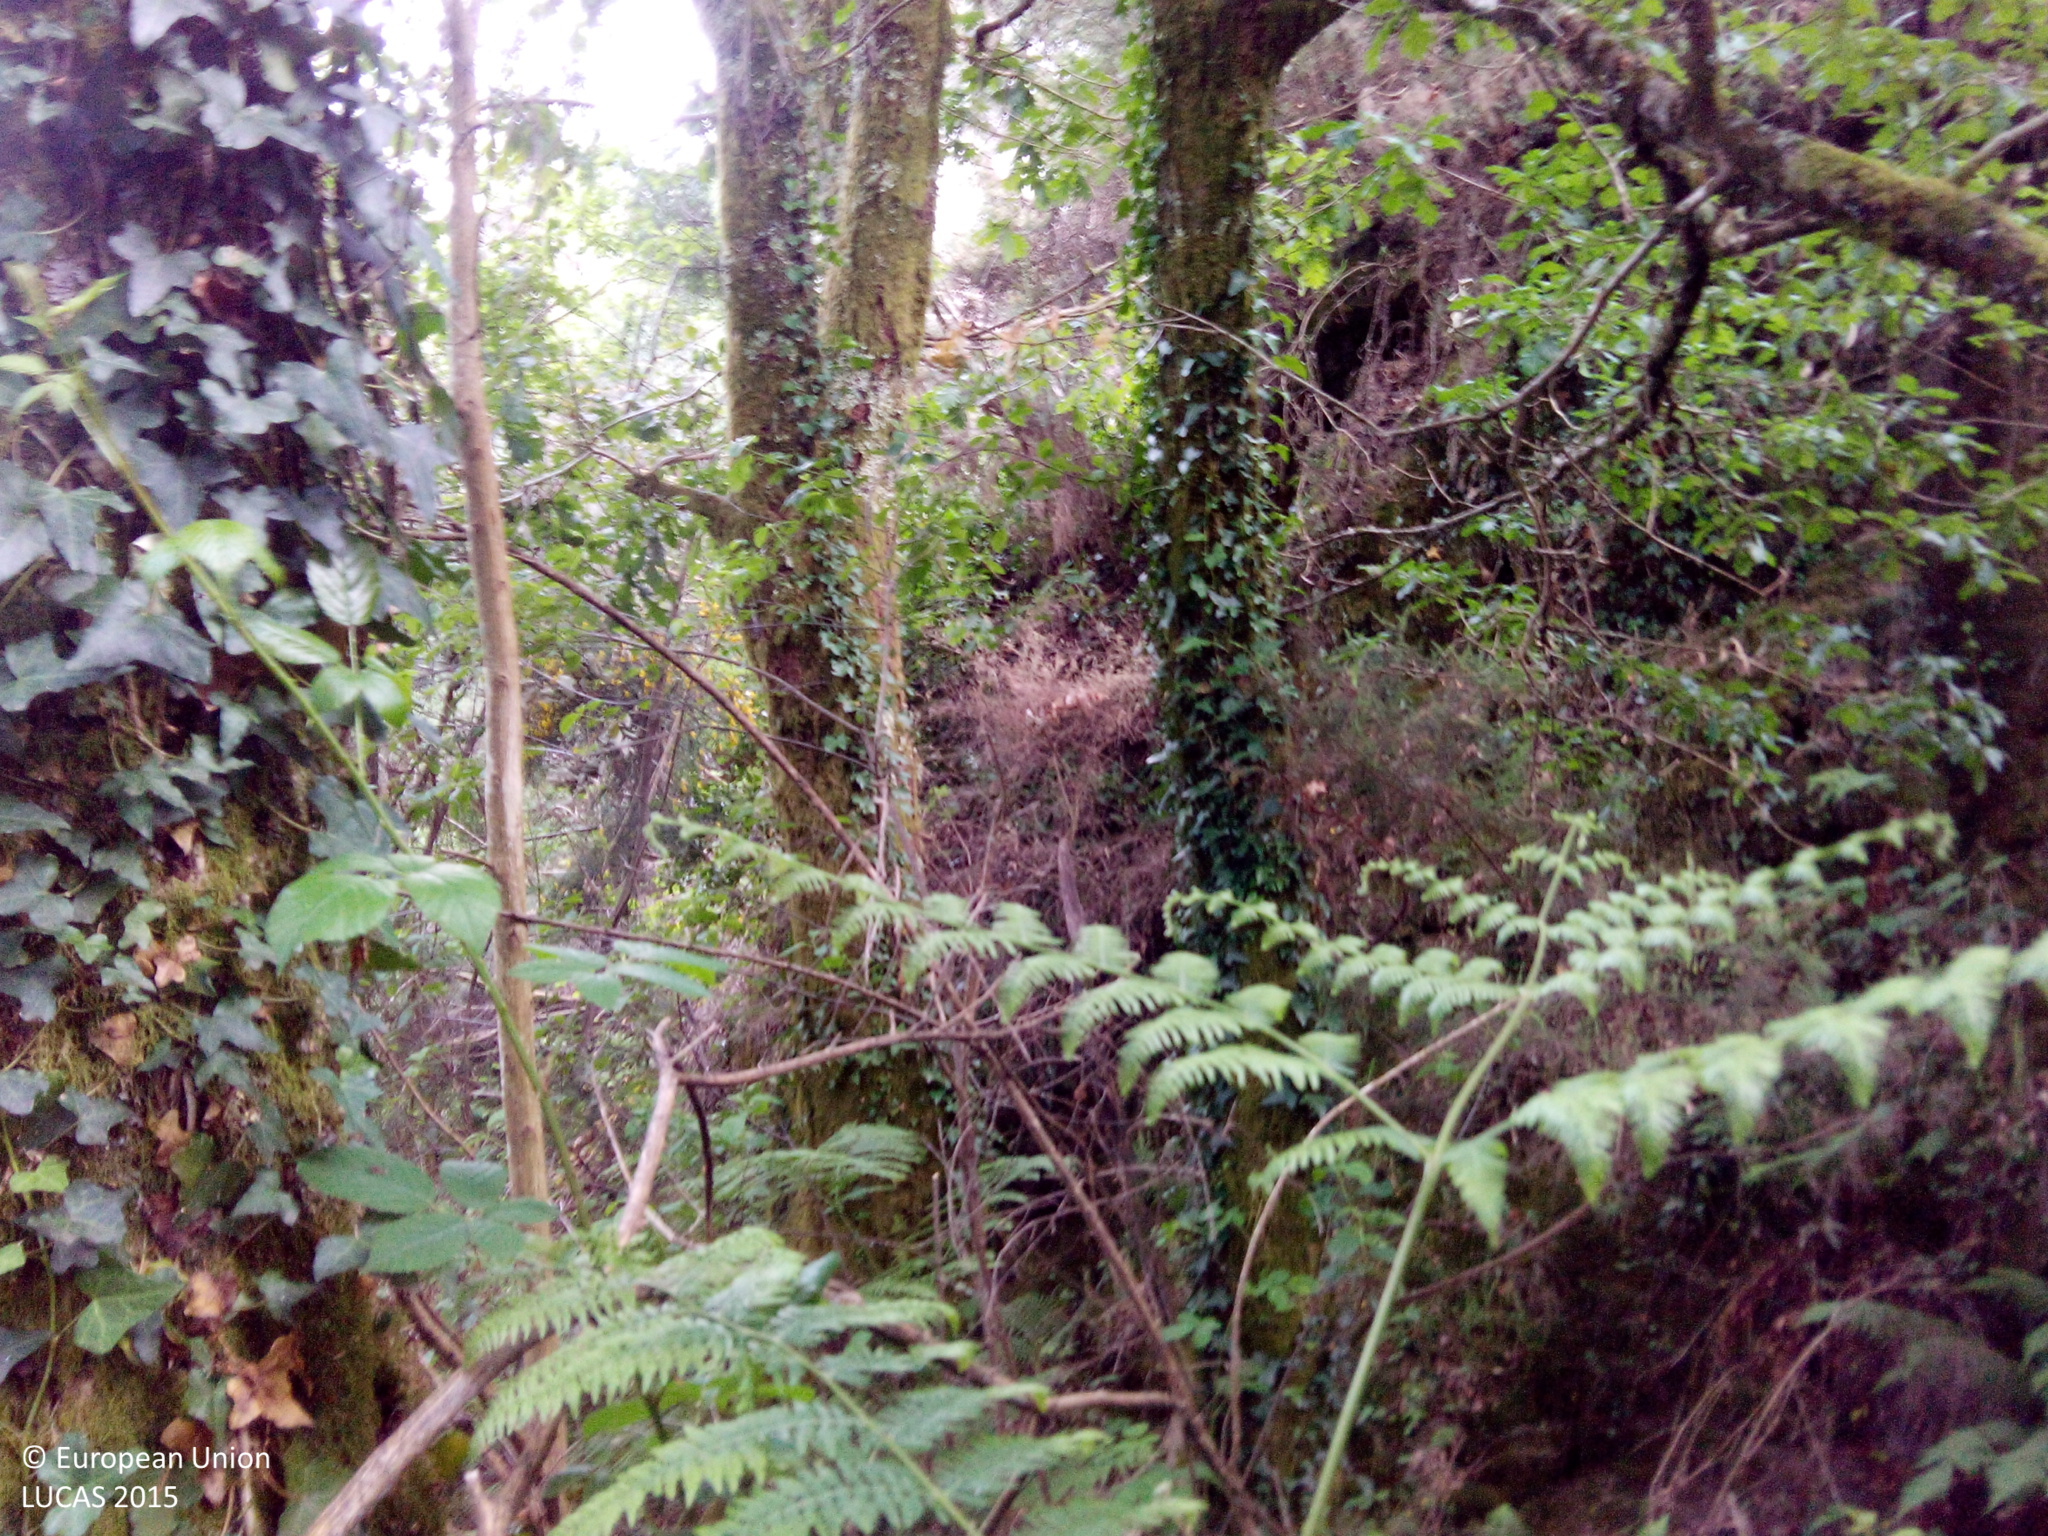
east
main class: Woodland
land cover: Broadleaved woodland
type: acidophilous oak and oak-birch forest
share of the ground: > 75 %
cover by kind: broadleaved forest trees 100 %
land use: Forestry
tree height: > 5 m
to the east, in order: Broadleaved woodland; Shrubland with sparse tree cover; Grassland without tree/shrub cover; Dry stone walls; Spontaneously vegetated surfaces; Dry stone walls; Spontaneously vegetated surfaces; Tracks
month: June
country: ES
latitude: 42.1476
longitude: -8.3237
